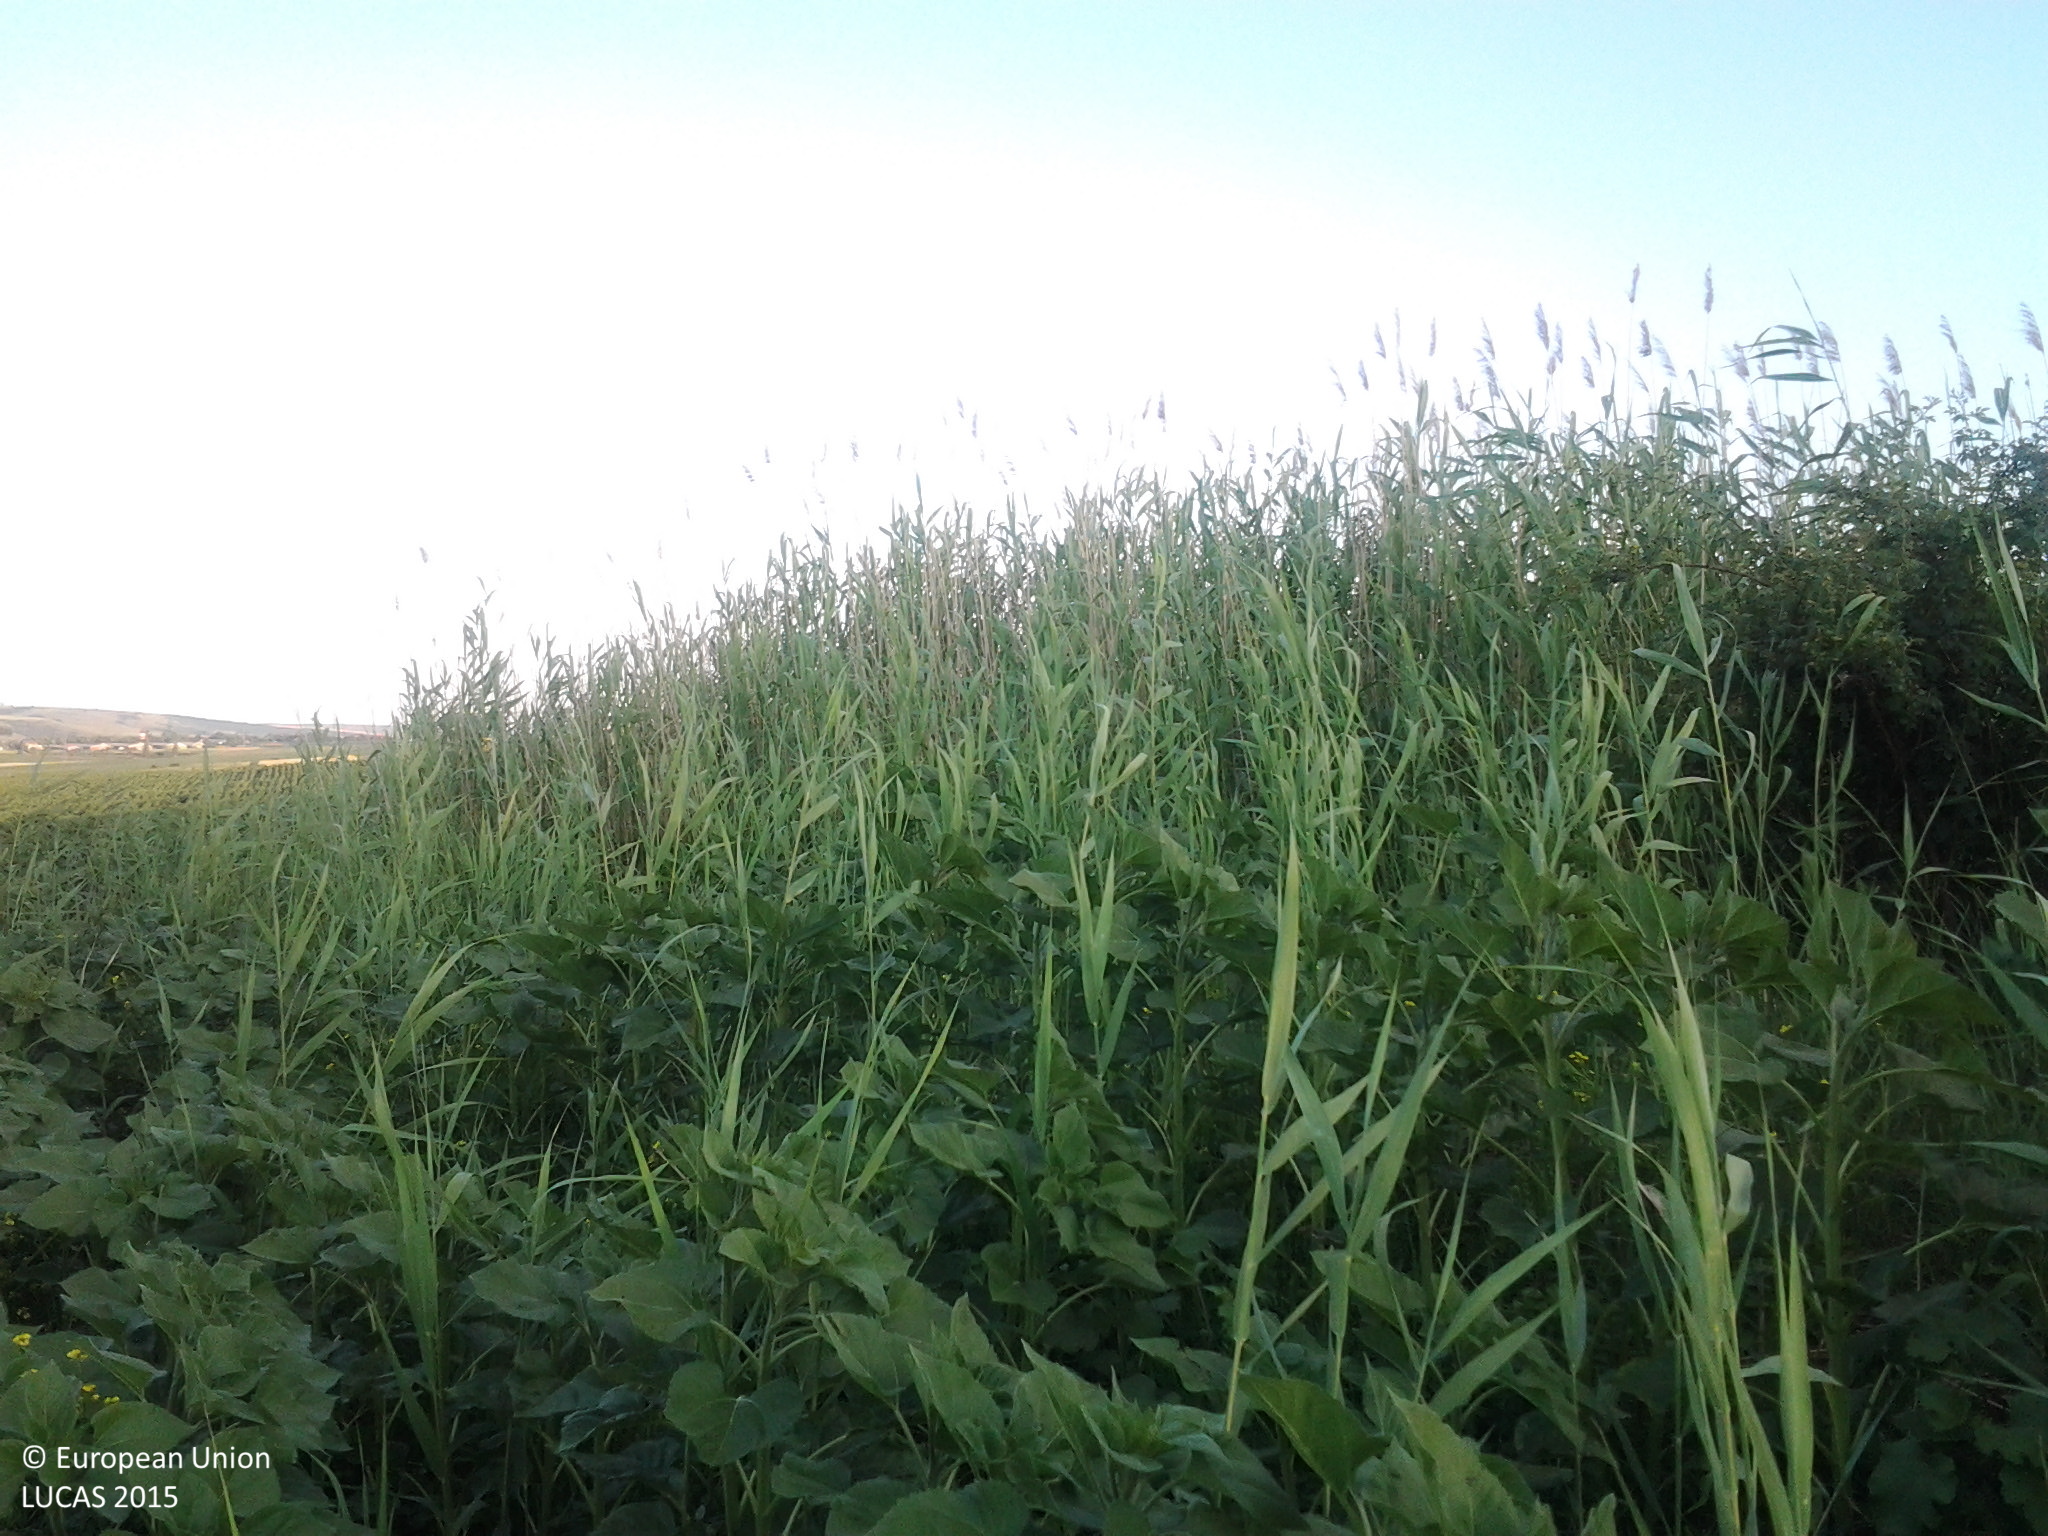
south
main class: Cropland
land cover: Sunflower
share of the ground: > 75 %
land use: Agriculture (excluding fallow land and kitchen gardens)
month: June
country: RO
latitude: 46.9083
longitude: 27.4556
